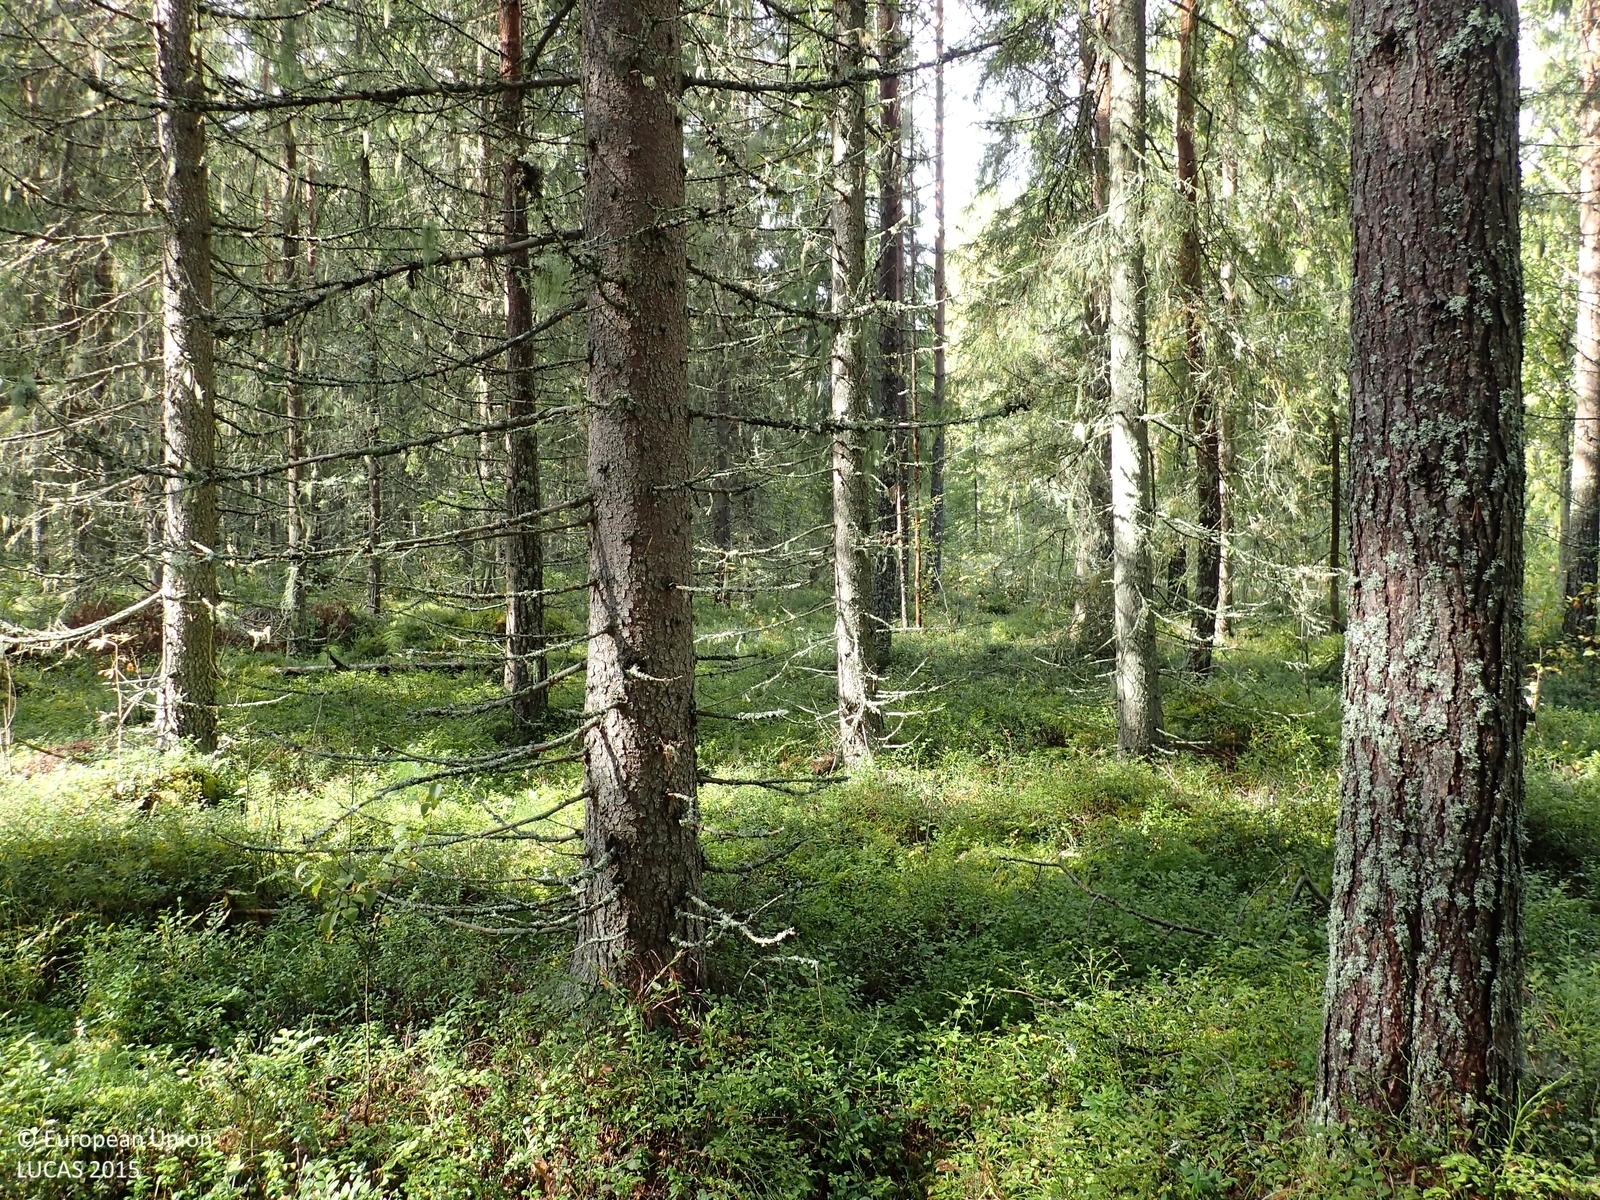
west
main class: Woodland
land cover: Other mixed woodland
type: boreal forest
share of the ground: > 75 %
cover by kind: coniferous forest trees 55 %, broadleaved forest trees 20 %, shrubs 20 %, lichens and mosses 5 %
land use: Forestry
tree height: > 5 m
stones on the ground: < 10 %
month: September
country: FI
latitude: 63.2240
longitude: 25.8507
